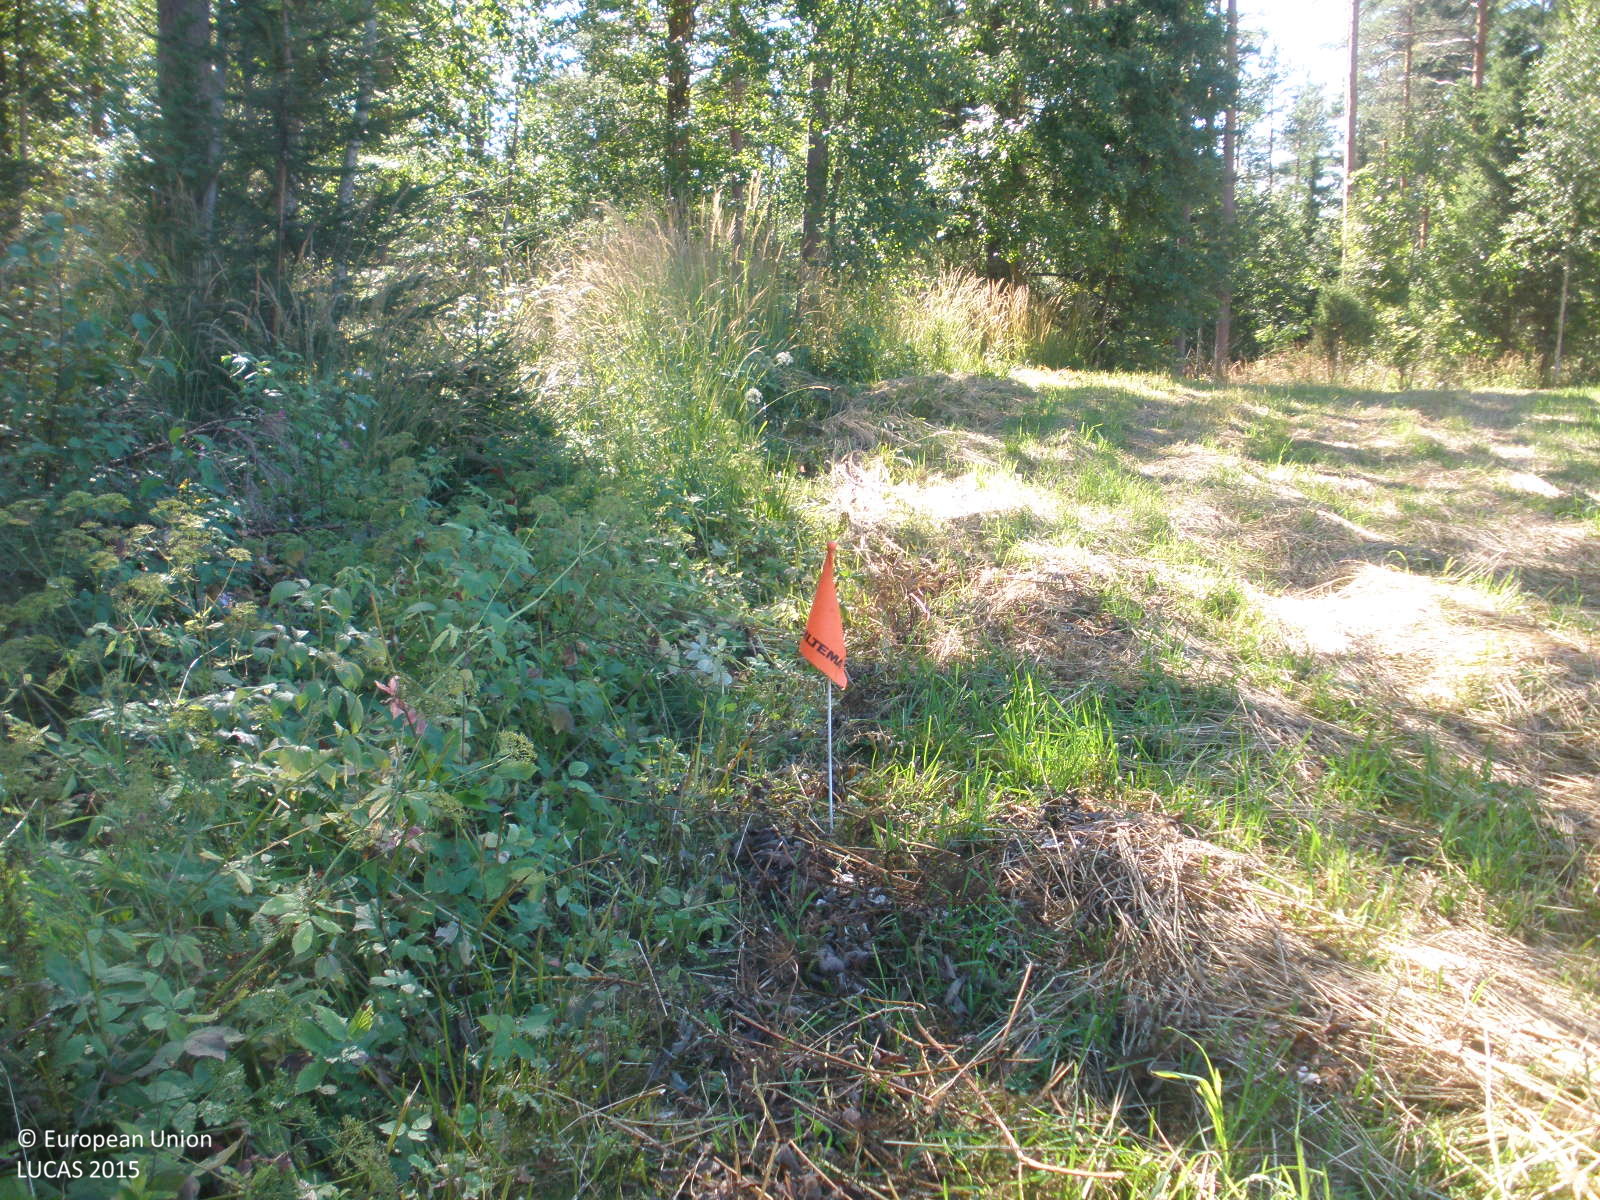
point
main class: Cropland
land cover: Mixed cereals for fodder
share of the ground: 25 - 50 %
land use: Agriculture (excluding fallow land and kitchen gardens)
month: August
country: FI
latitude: 60.6002
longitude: 23.9553
